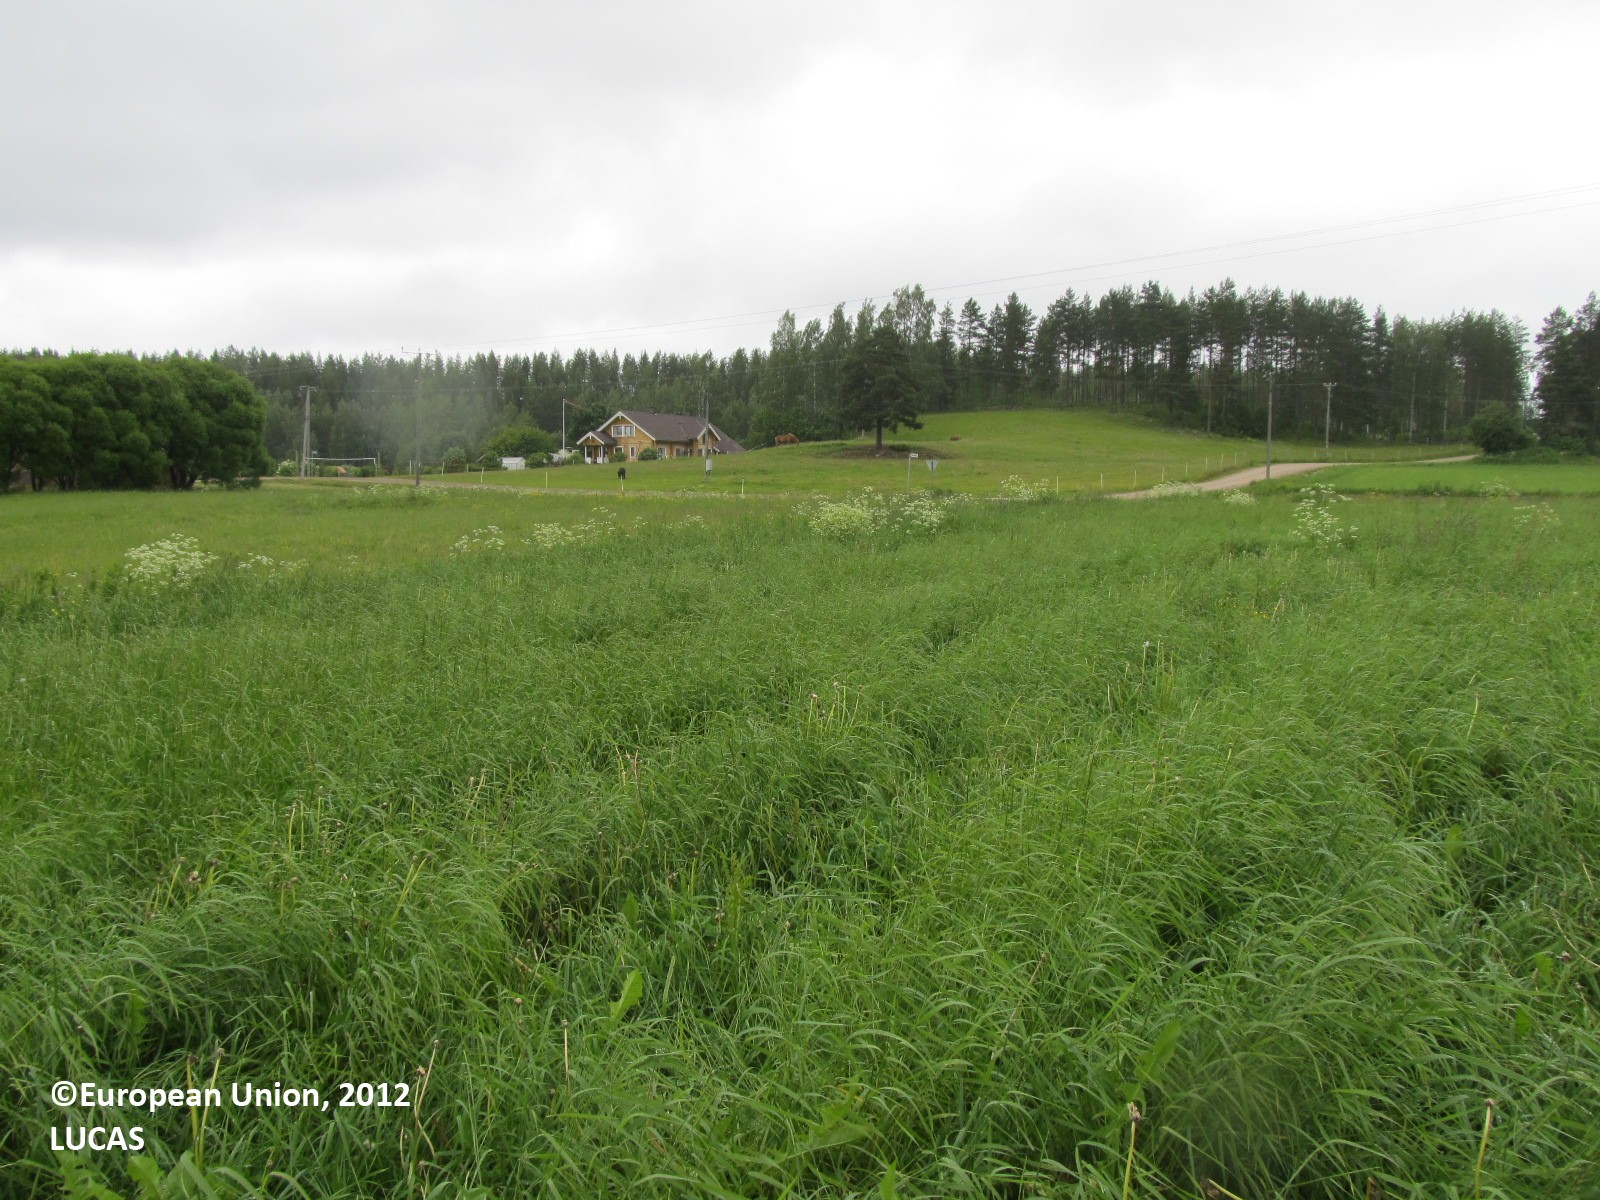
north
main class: Grassland
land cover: Grassland without tree/shrub cover
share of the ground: 50 - 75 %
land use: Fallow land
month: June
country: FI
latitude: 62.7713
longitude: 28.8006
